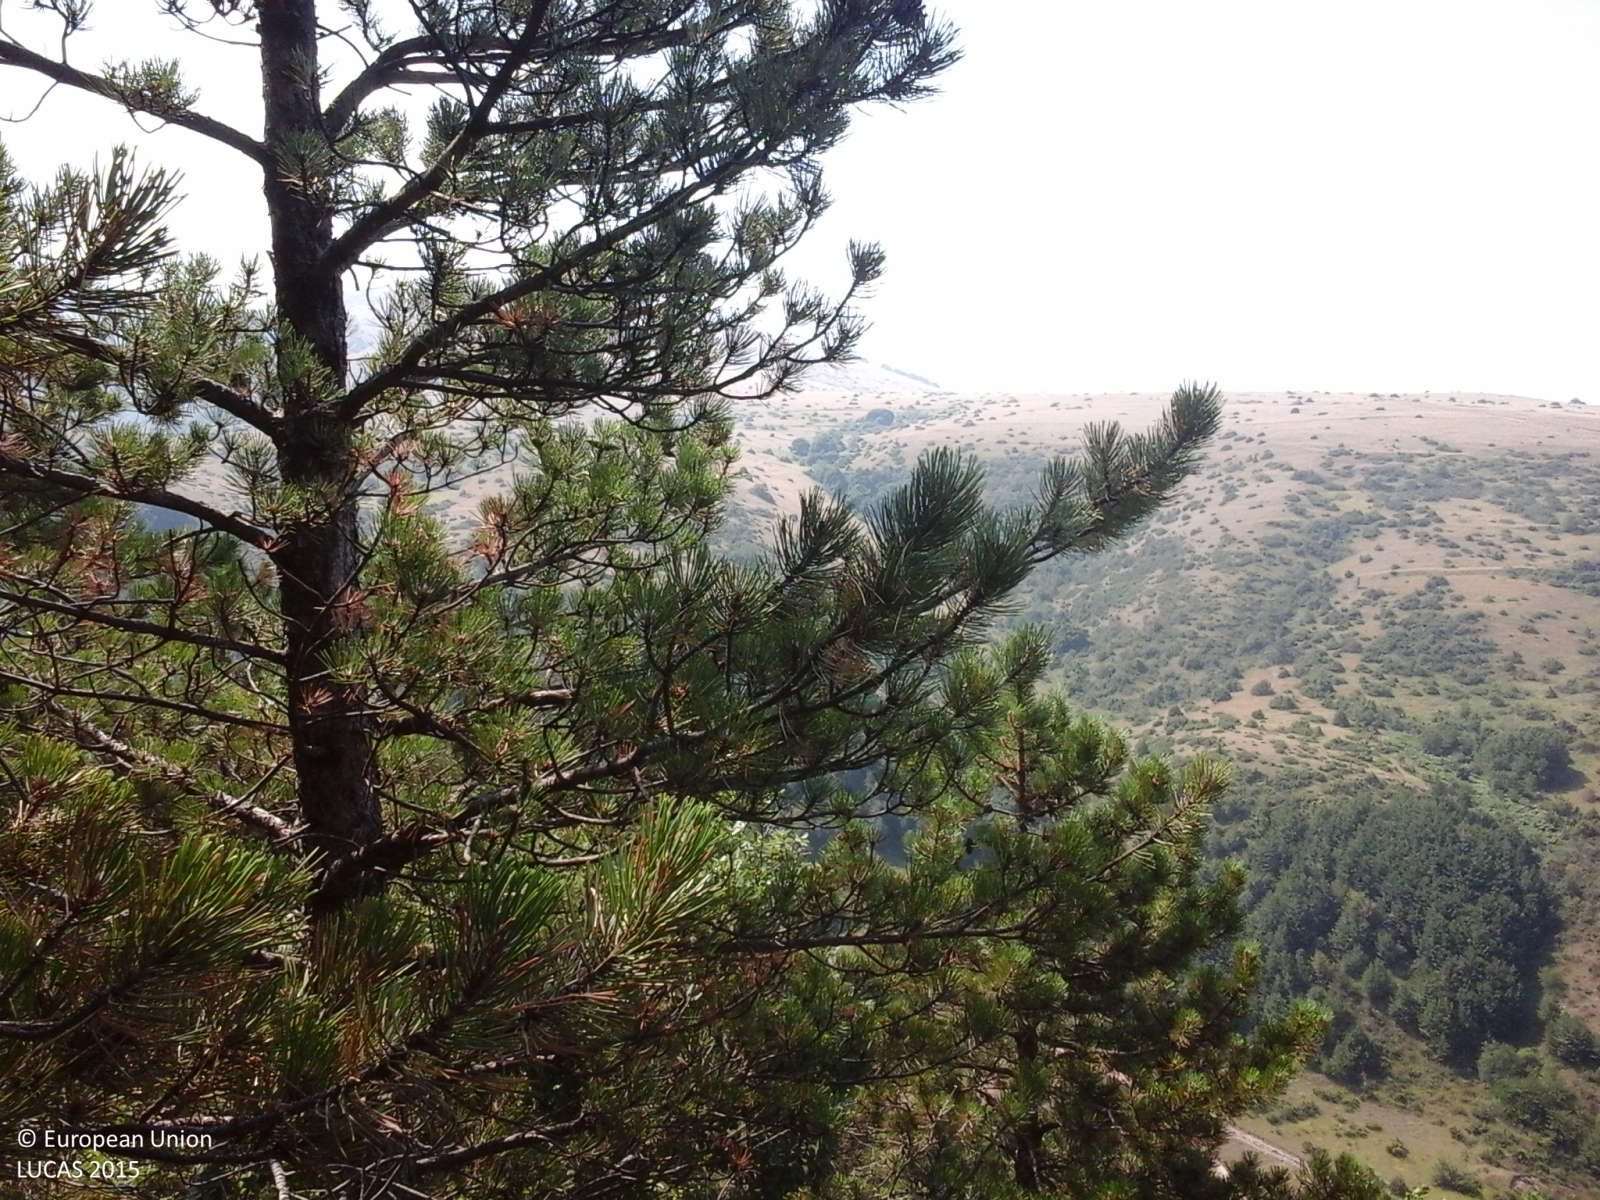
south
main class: Woodland
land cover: Other mixed woodland
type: thermophilous deciduous forest
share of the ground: > 75 %
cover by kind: broadleaved forest trees 75 %, coniferous forest trees 25 %
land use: Forestry
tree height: < 5 m
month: August
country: IT
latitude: 43.0216
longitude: 13.1203
